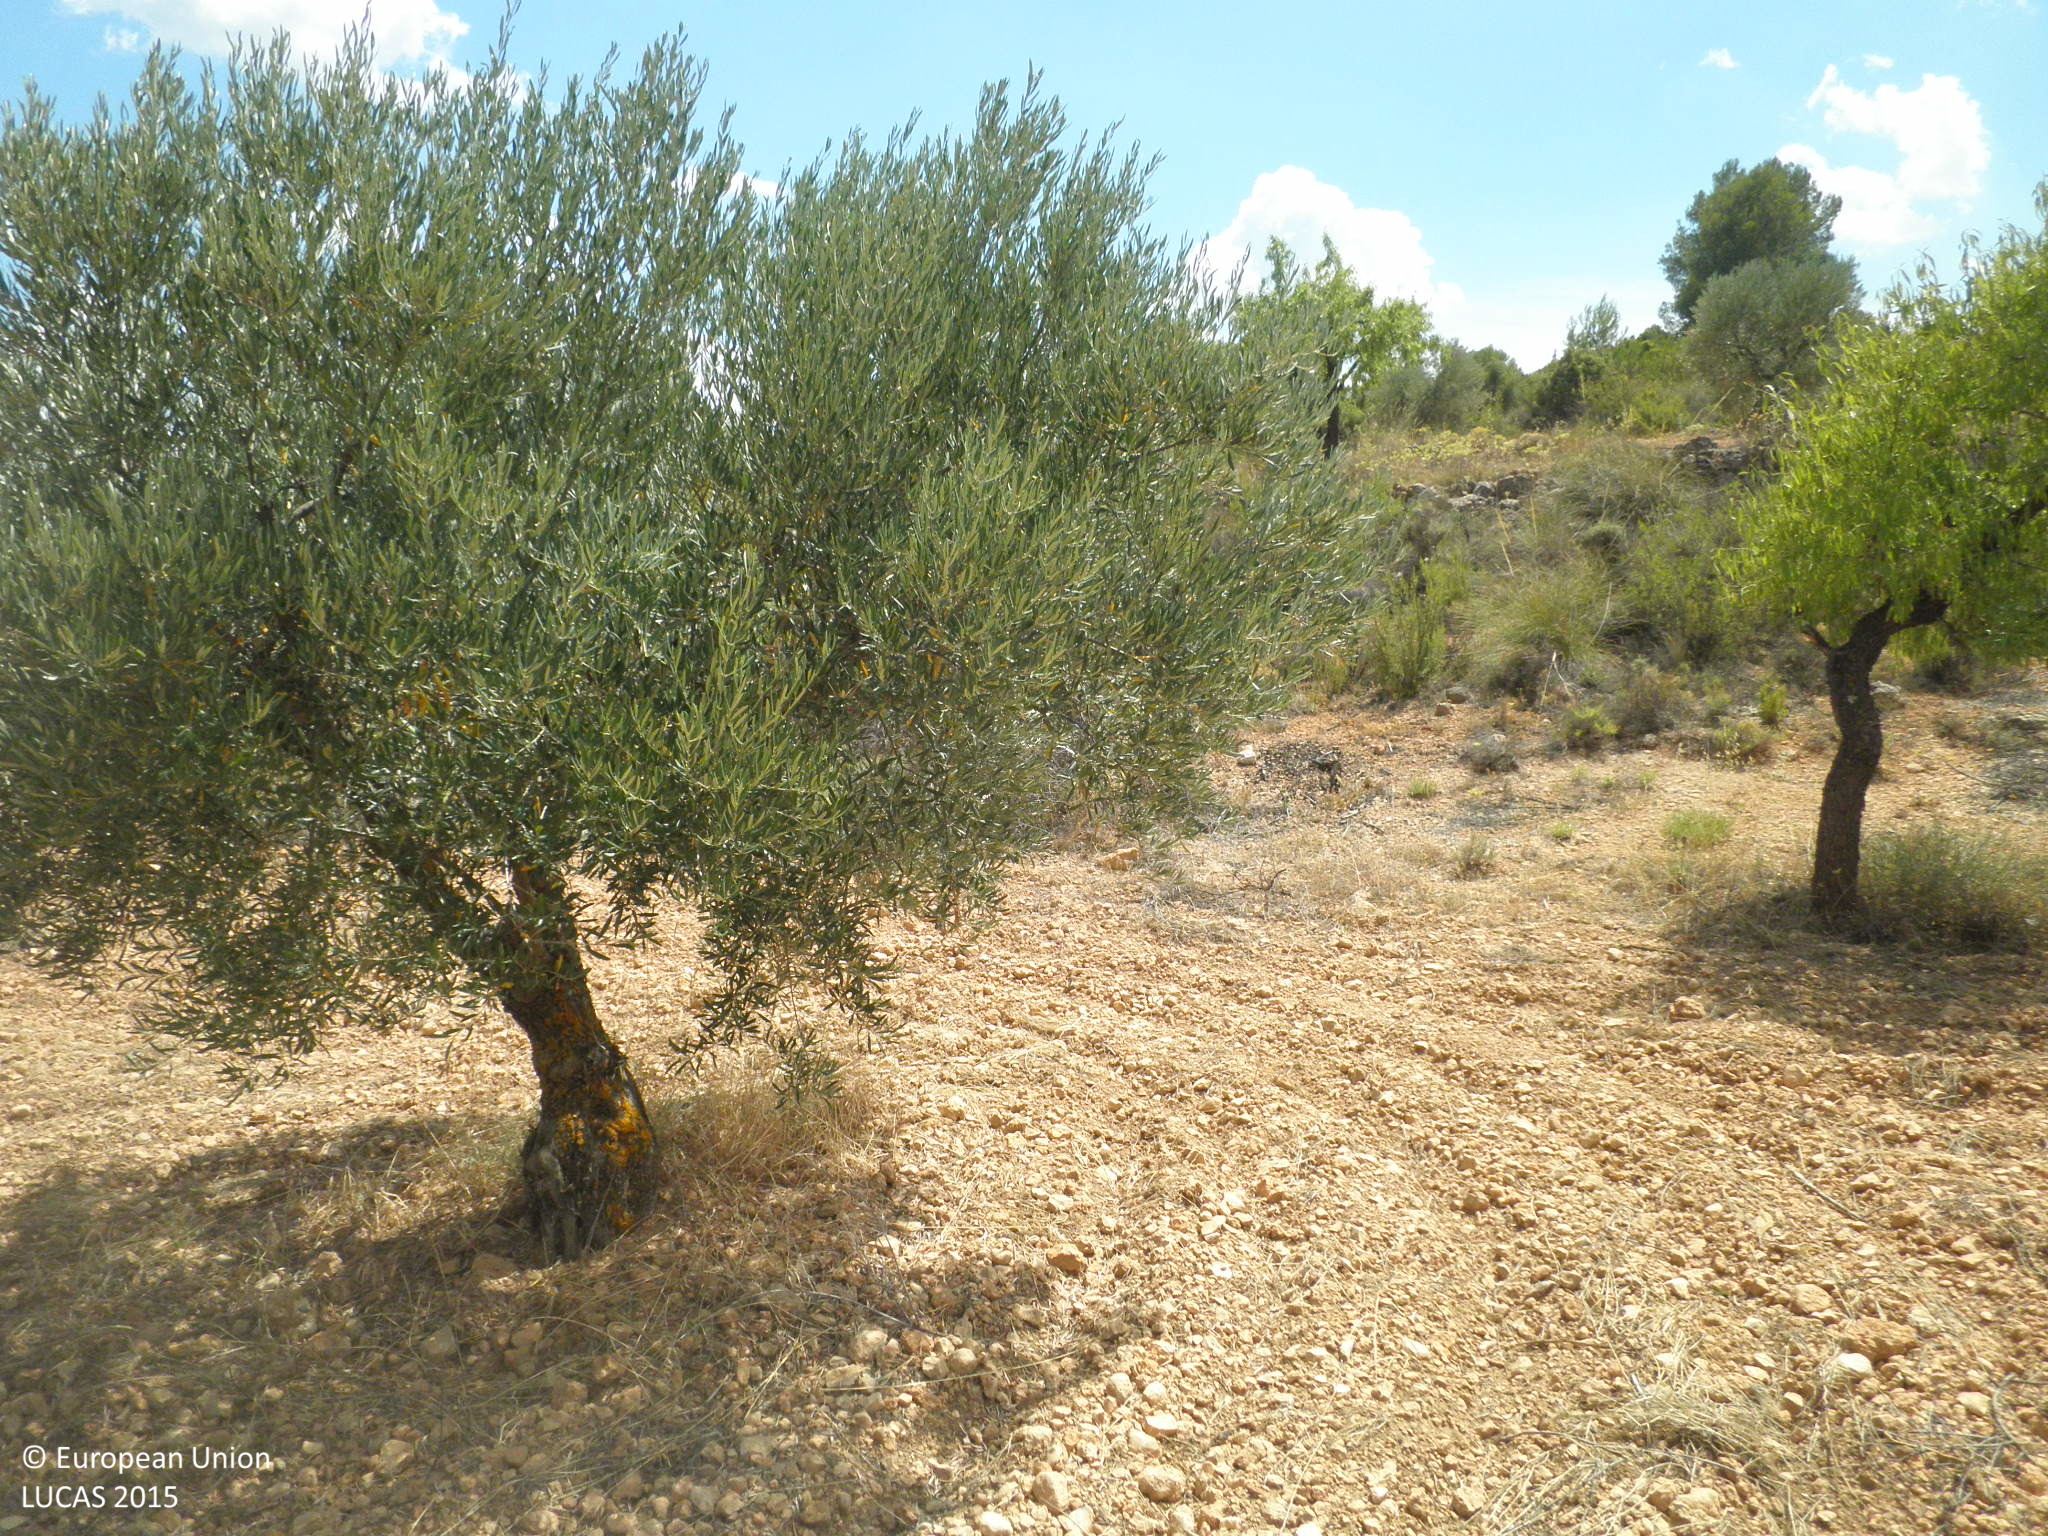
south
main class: Cropland
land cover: Olive groves
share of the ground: 10 - 25 %
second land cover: Other bare soil
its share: > 75 %
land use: Agriculture (excluding fallow land and kitchen gardens)
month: July
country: ES
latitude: 39.6675
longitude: -1.6054
